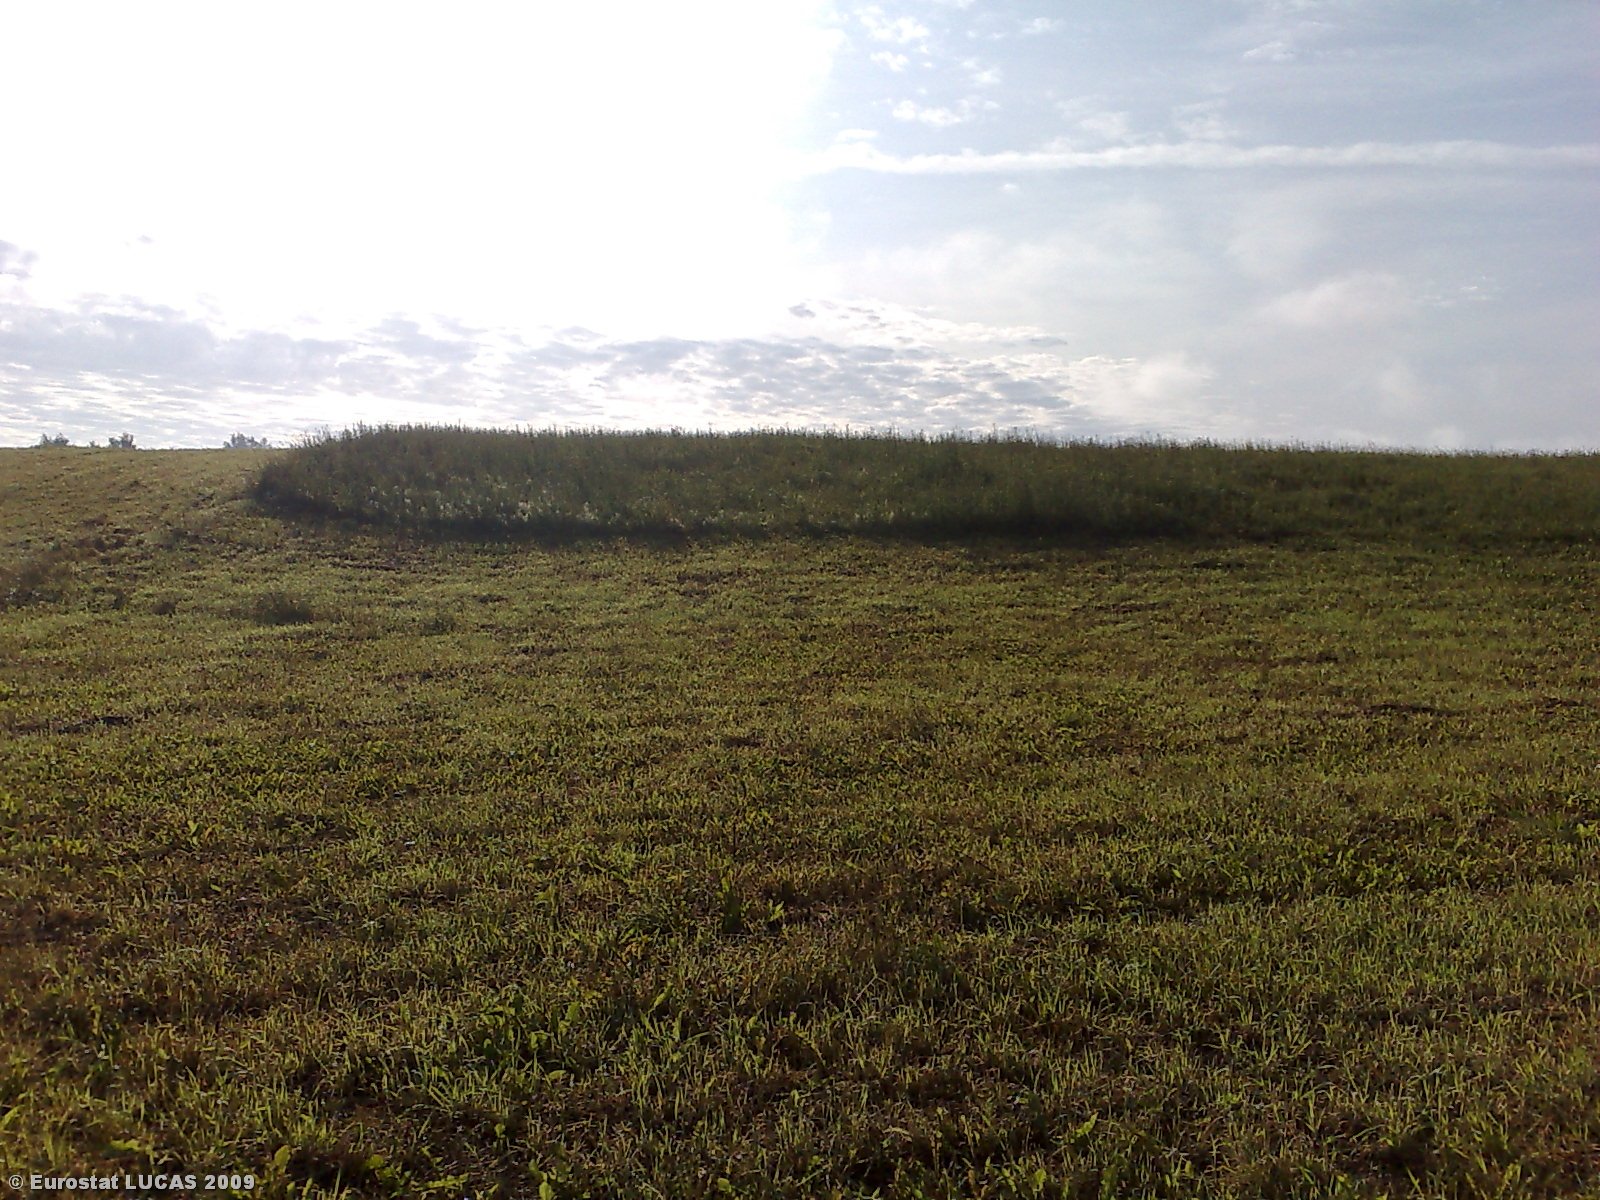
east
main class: Grassland
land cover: Grassland without tree/shrub cover
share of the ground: > 75 %
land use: Agriculture (excluding fallow land and kitchen gardens)
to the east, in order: Grassland without tree/shrub cover; Oats
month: July
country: LT
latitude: 55.6708
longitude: 22.8012
